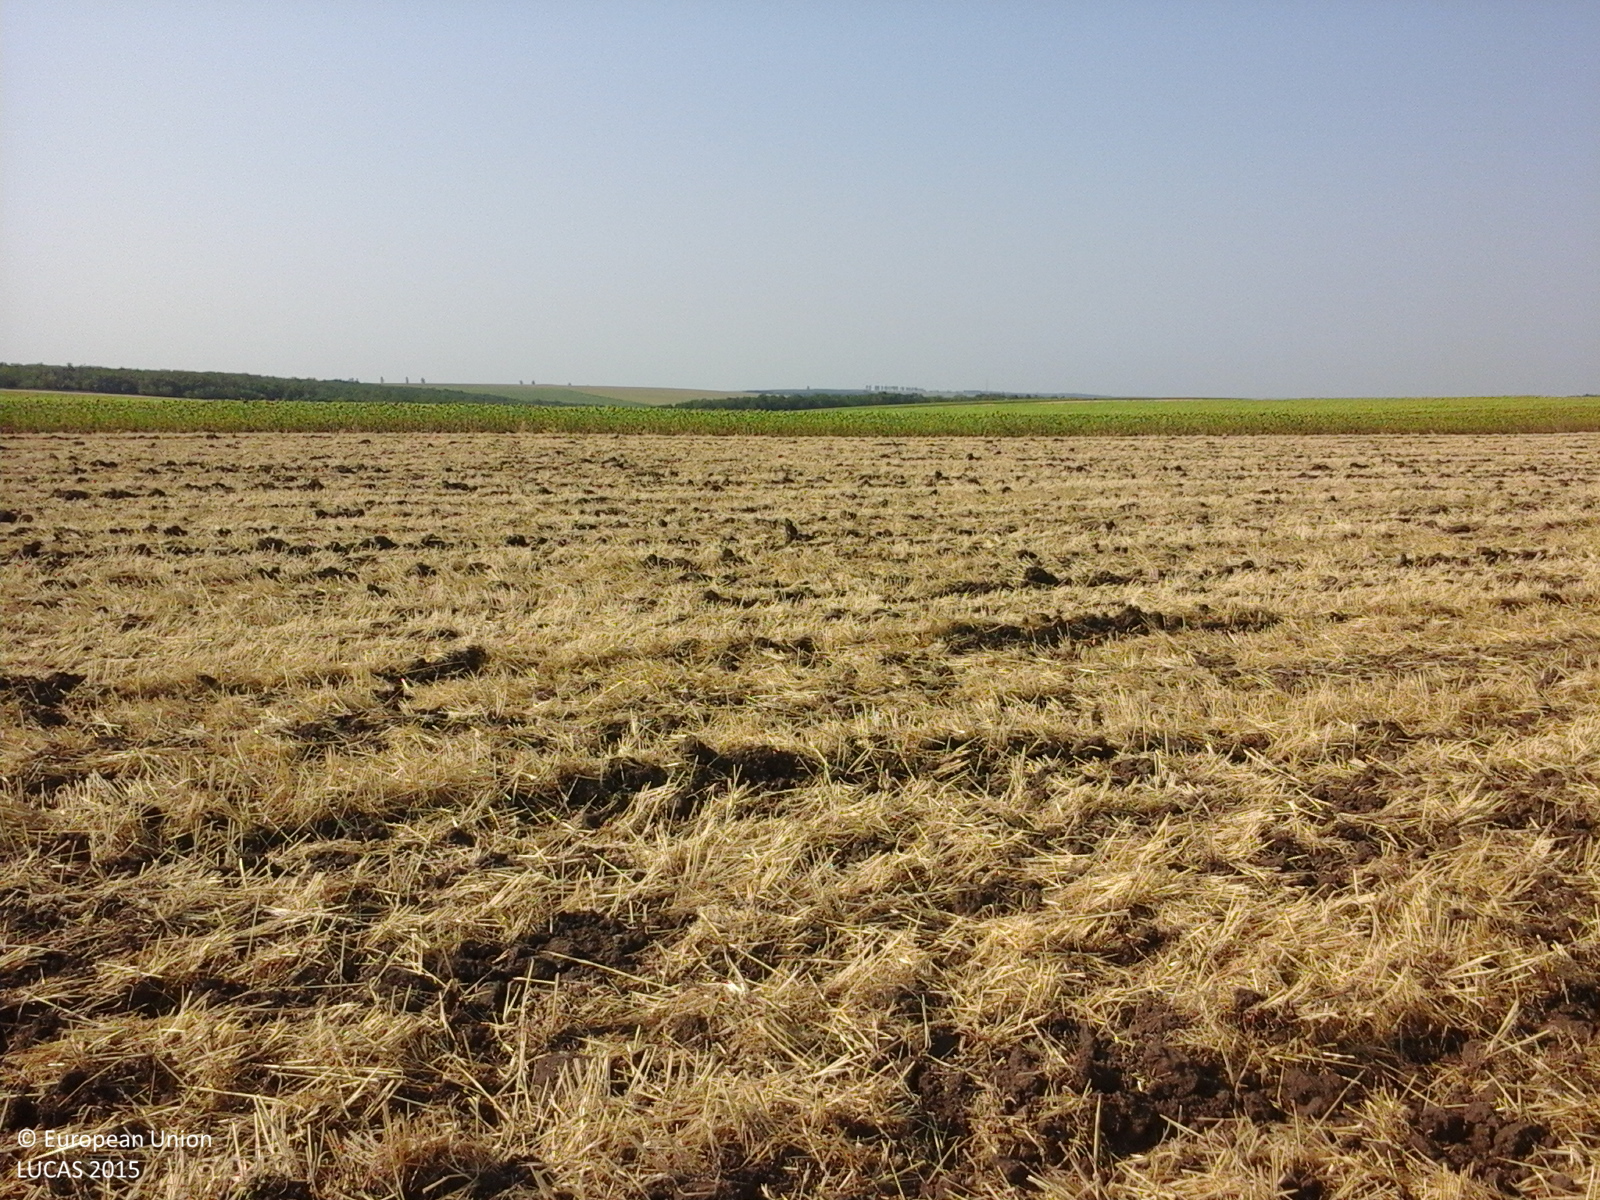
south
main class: Cropland
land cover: Common wheat
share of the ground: 10 - 25 %
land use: Agriculture (excluding fallow land and kitchen gardens)
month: July
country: RO
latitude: 45.7696
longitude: 27.8747
